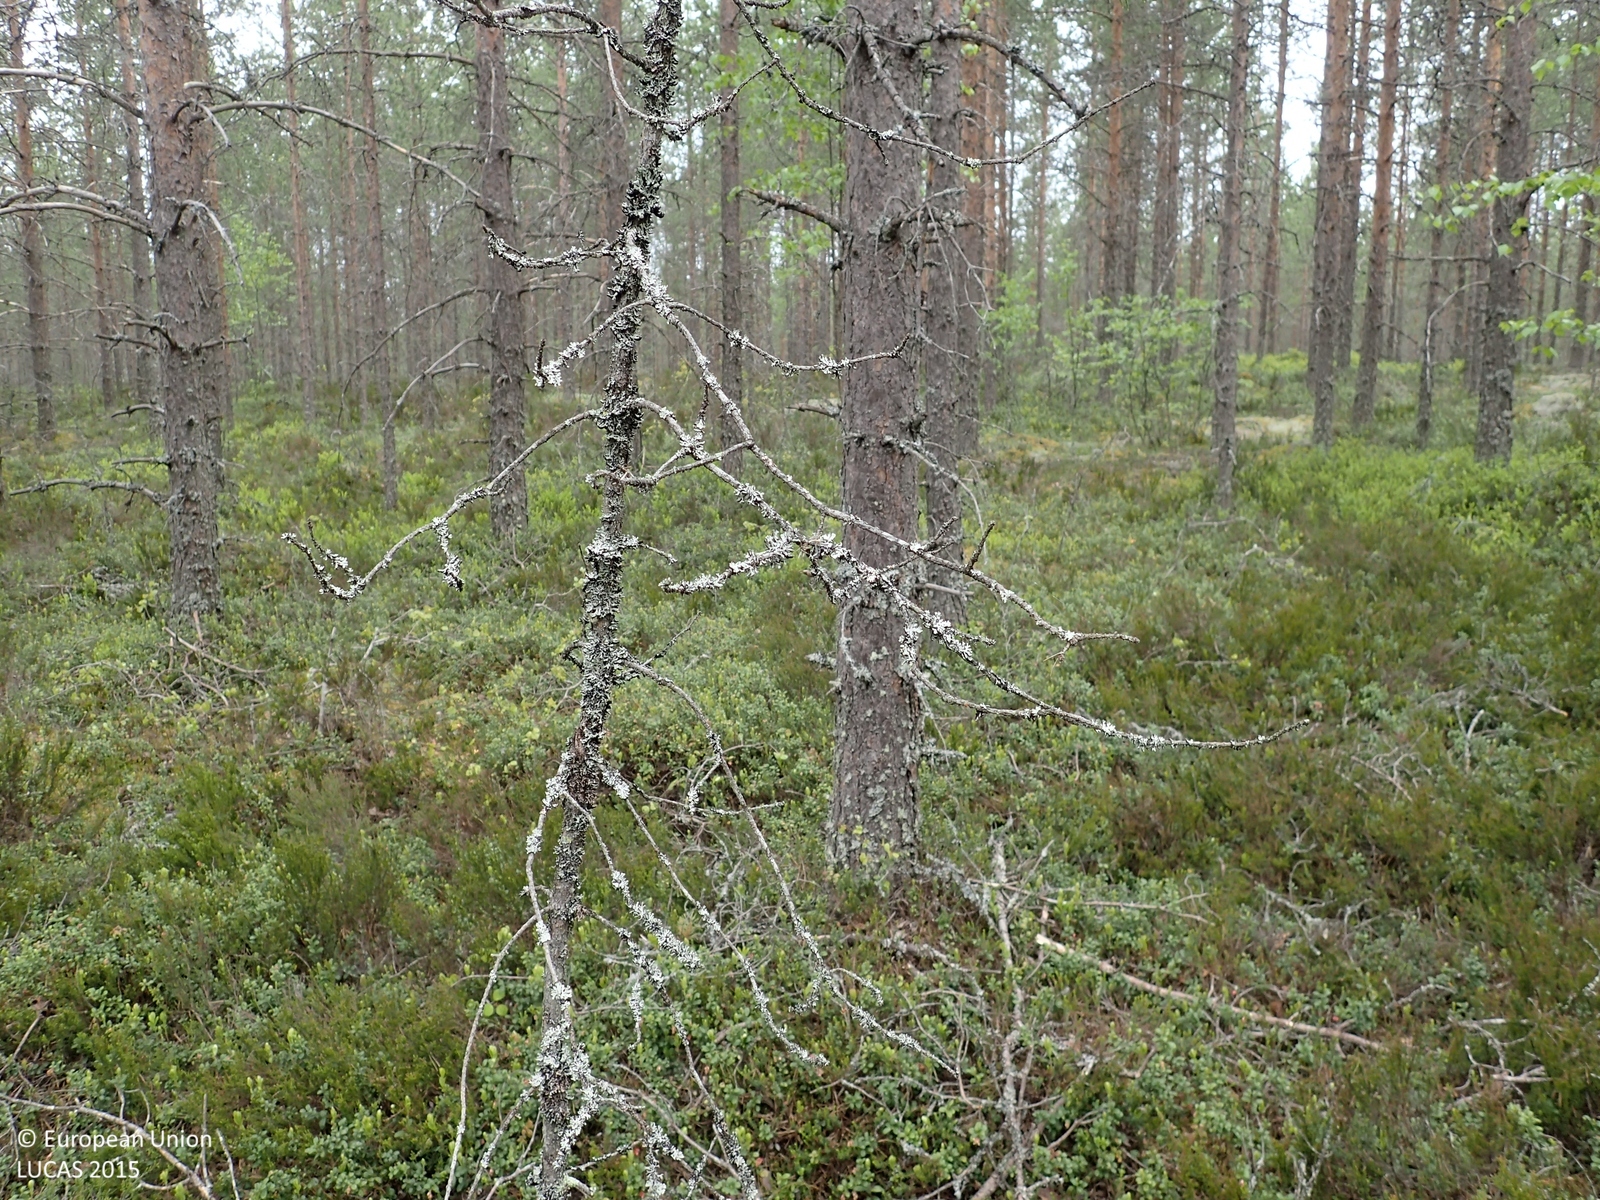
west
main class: Woodland
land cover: Pine dominated coniferous woodland
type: boreal forest
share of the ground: 50 - 75 %
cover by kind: coniferous forest trees 60 %, shrubs 35 %, broadleaved forest trees 5 %
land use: Forestry
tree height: > 5 m
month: June
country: FI
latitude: 62.3473
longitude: 22.4755
